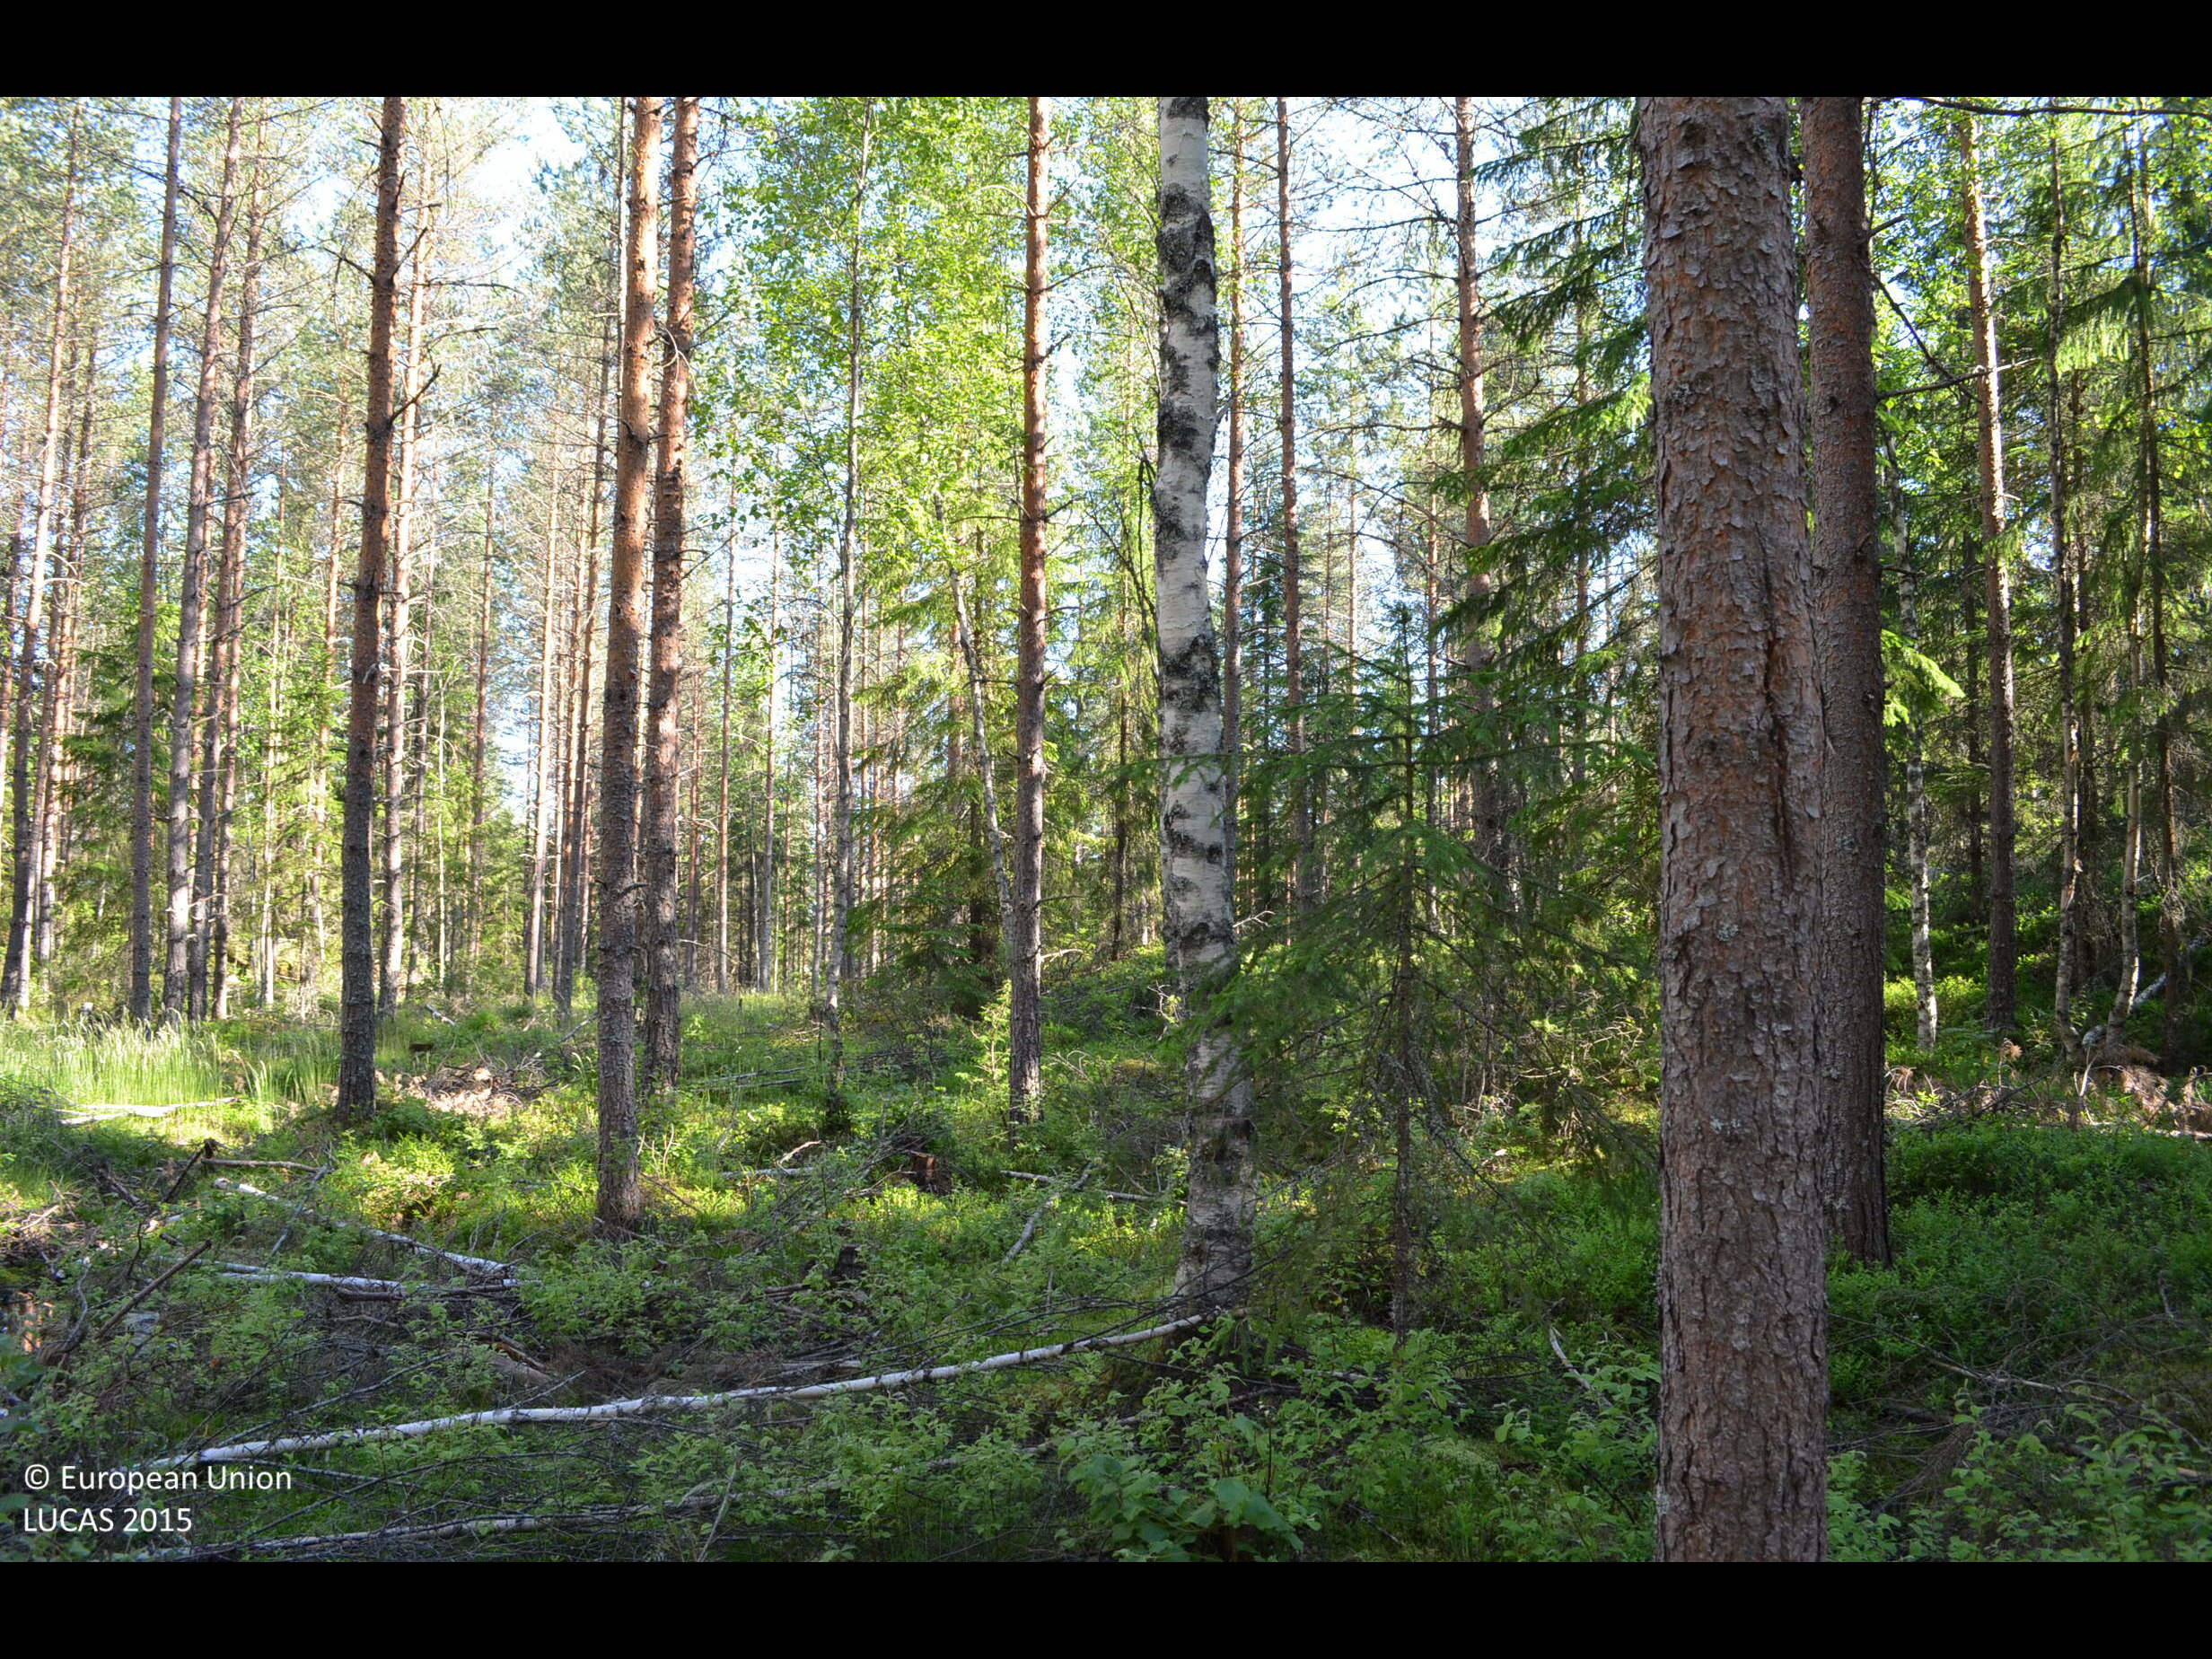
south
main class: Woodland
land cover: Pine dominated coniferous woodland
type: boreal forest
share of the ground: > 75 %
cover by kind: coniferous forest trees 70 %, shrubs 15 %, broadleaved forest trees 10 %, herbaceous plants 5 %
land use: Forestry
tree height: > 5 m
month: July
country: FI
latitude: 61.7683
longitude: 23.4359
